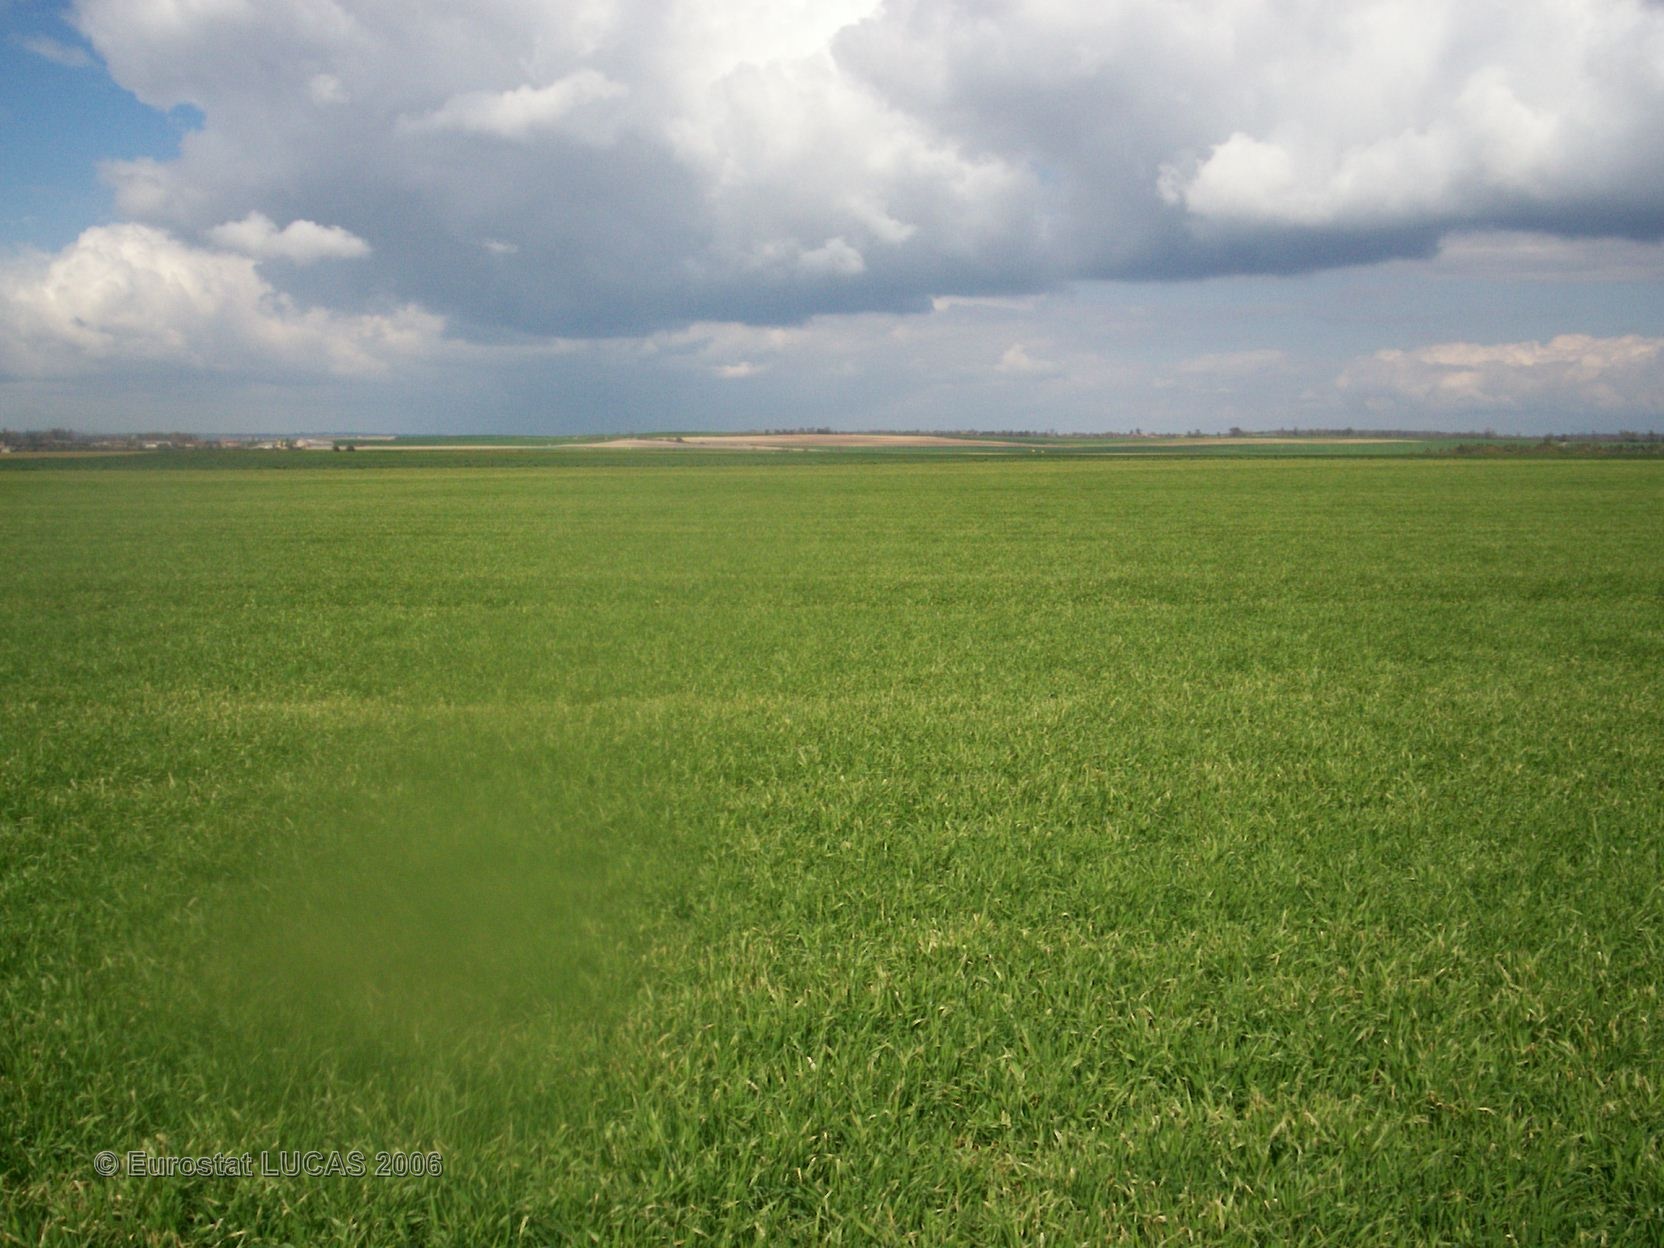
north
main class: Cropland
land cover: Common wheat
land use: Agriculture (excluding fallow land and kitchen gardens)
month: April
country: FR
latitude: 48.9045
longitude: -0.0585
